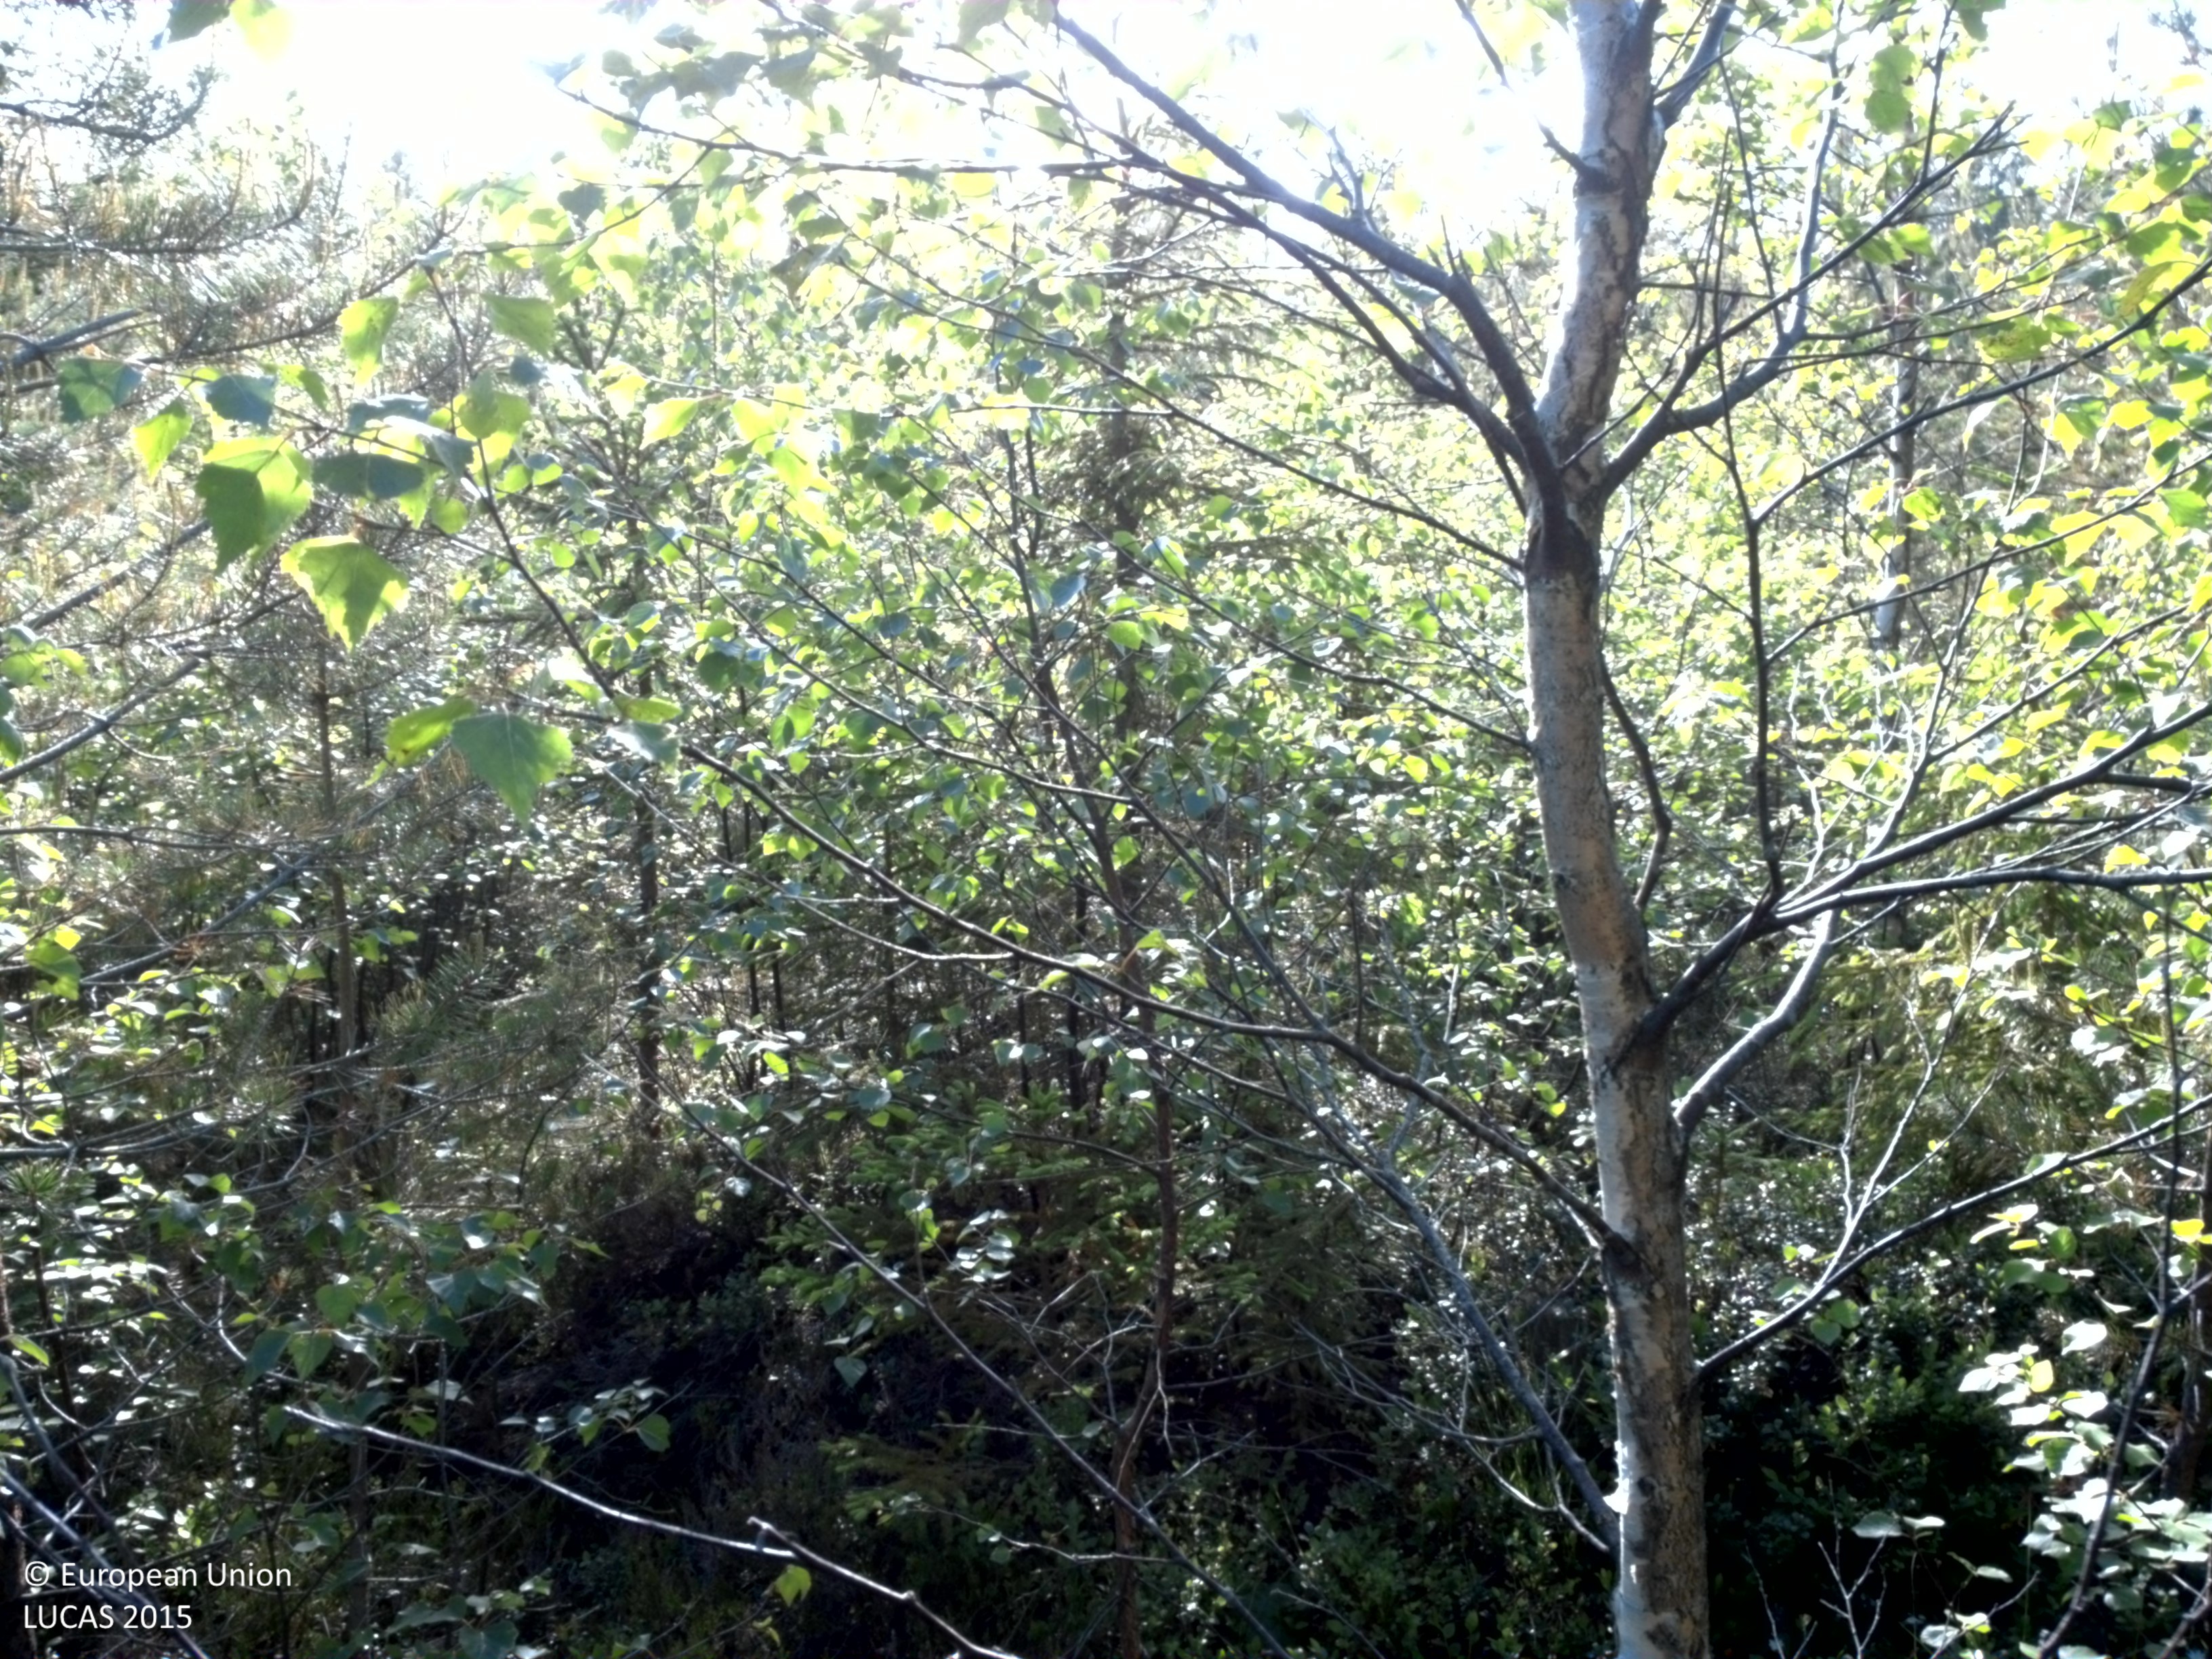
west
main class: Woodland
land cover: Spruce dominated mixed woodland
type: boreal forest
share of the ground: 25 - 50 %
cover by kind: coniferous forest trees 30 %, shrubs 25 %, herbaceous plants 25 %, broadleaved forest trees 20 %
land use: Forestry
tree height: < 5 m
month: June
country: SE
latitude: 64.2198
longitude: 20.6766
